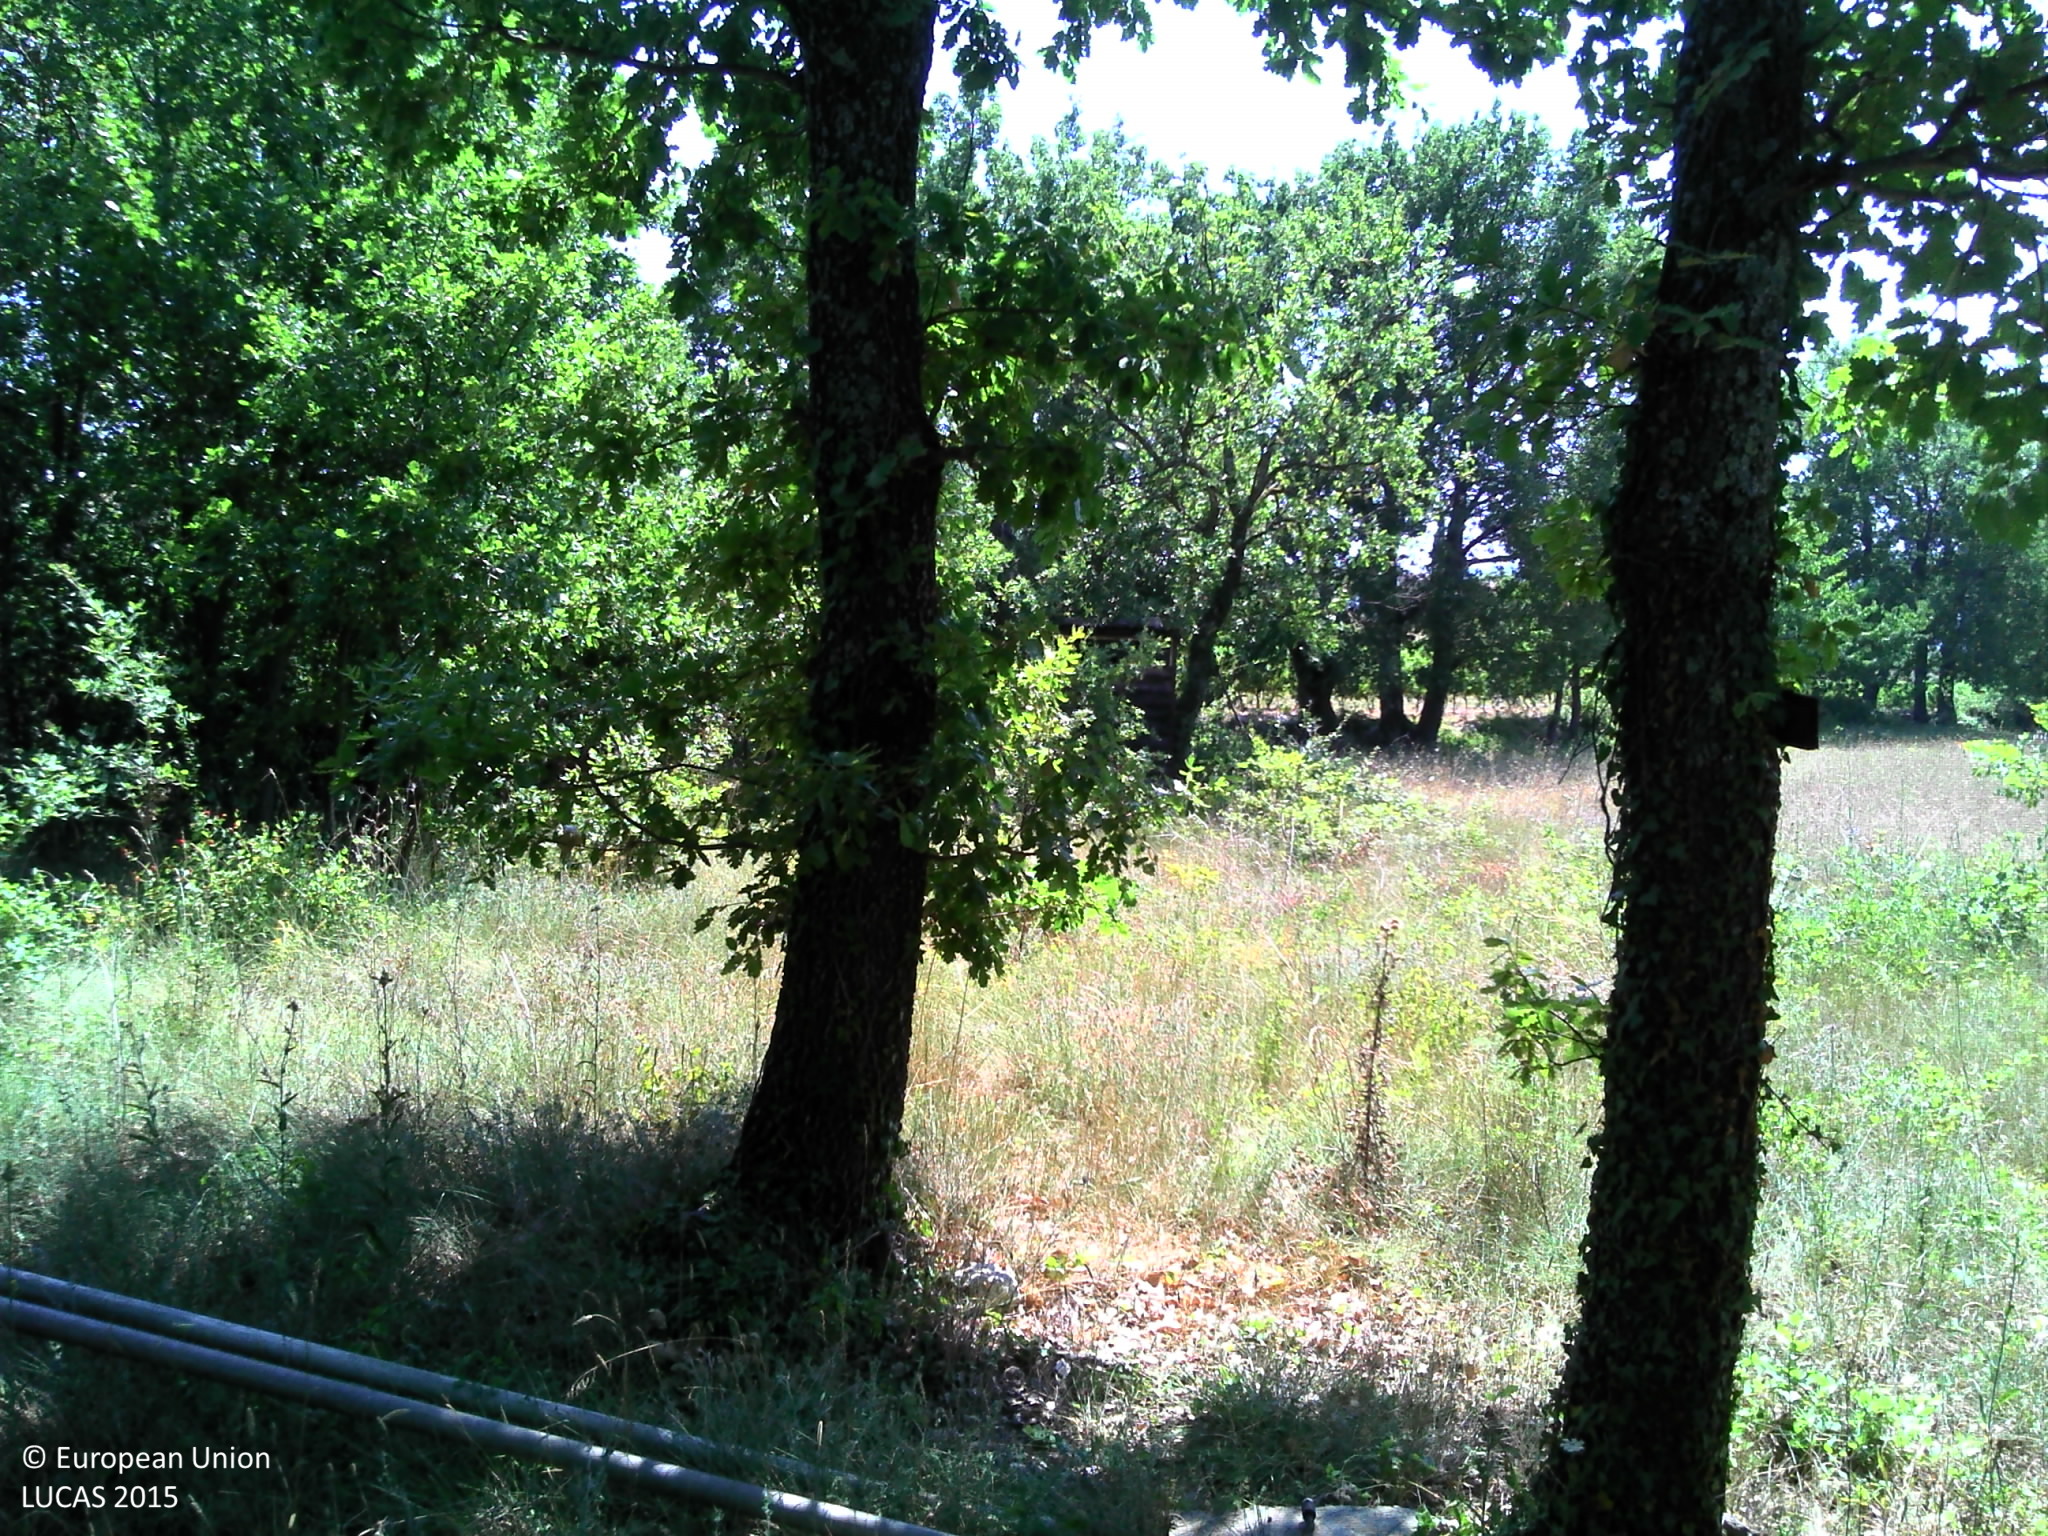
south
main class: Woodland
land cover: Broadleaved woodland
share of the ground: > 75 %
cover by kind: broadleaved forest trees 60 %, herbaceous plants 30 %, coniferous forest trees 5 %, shrubs 5 %
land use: Residential
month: August
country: FR
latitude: 43.8475
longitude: 5.3193
